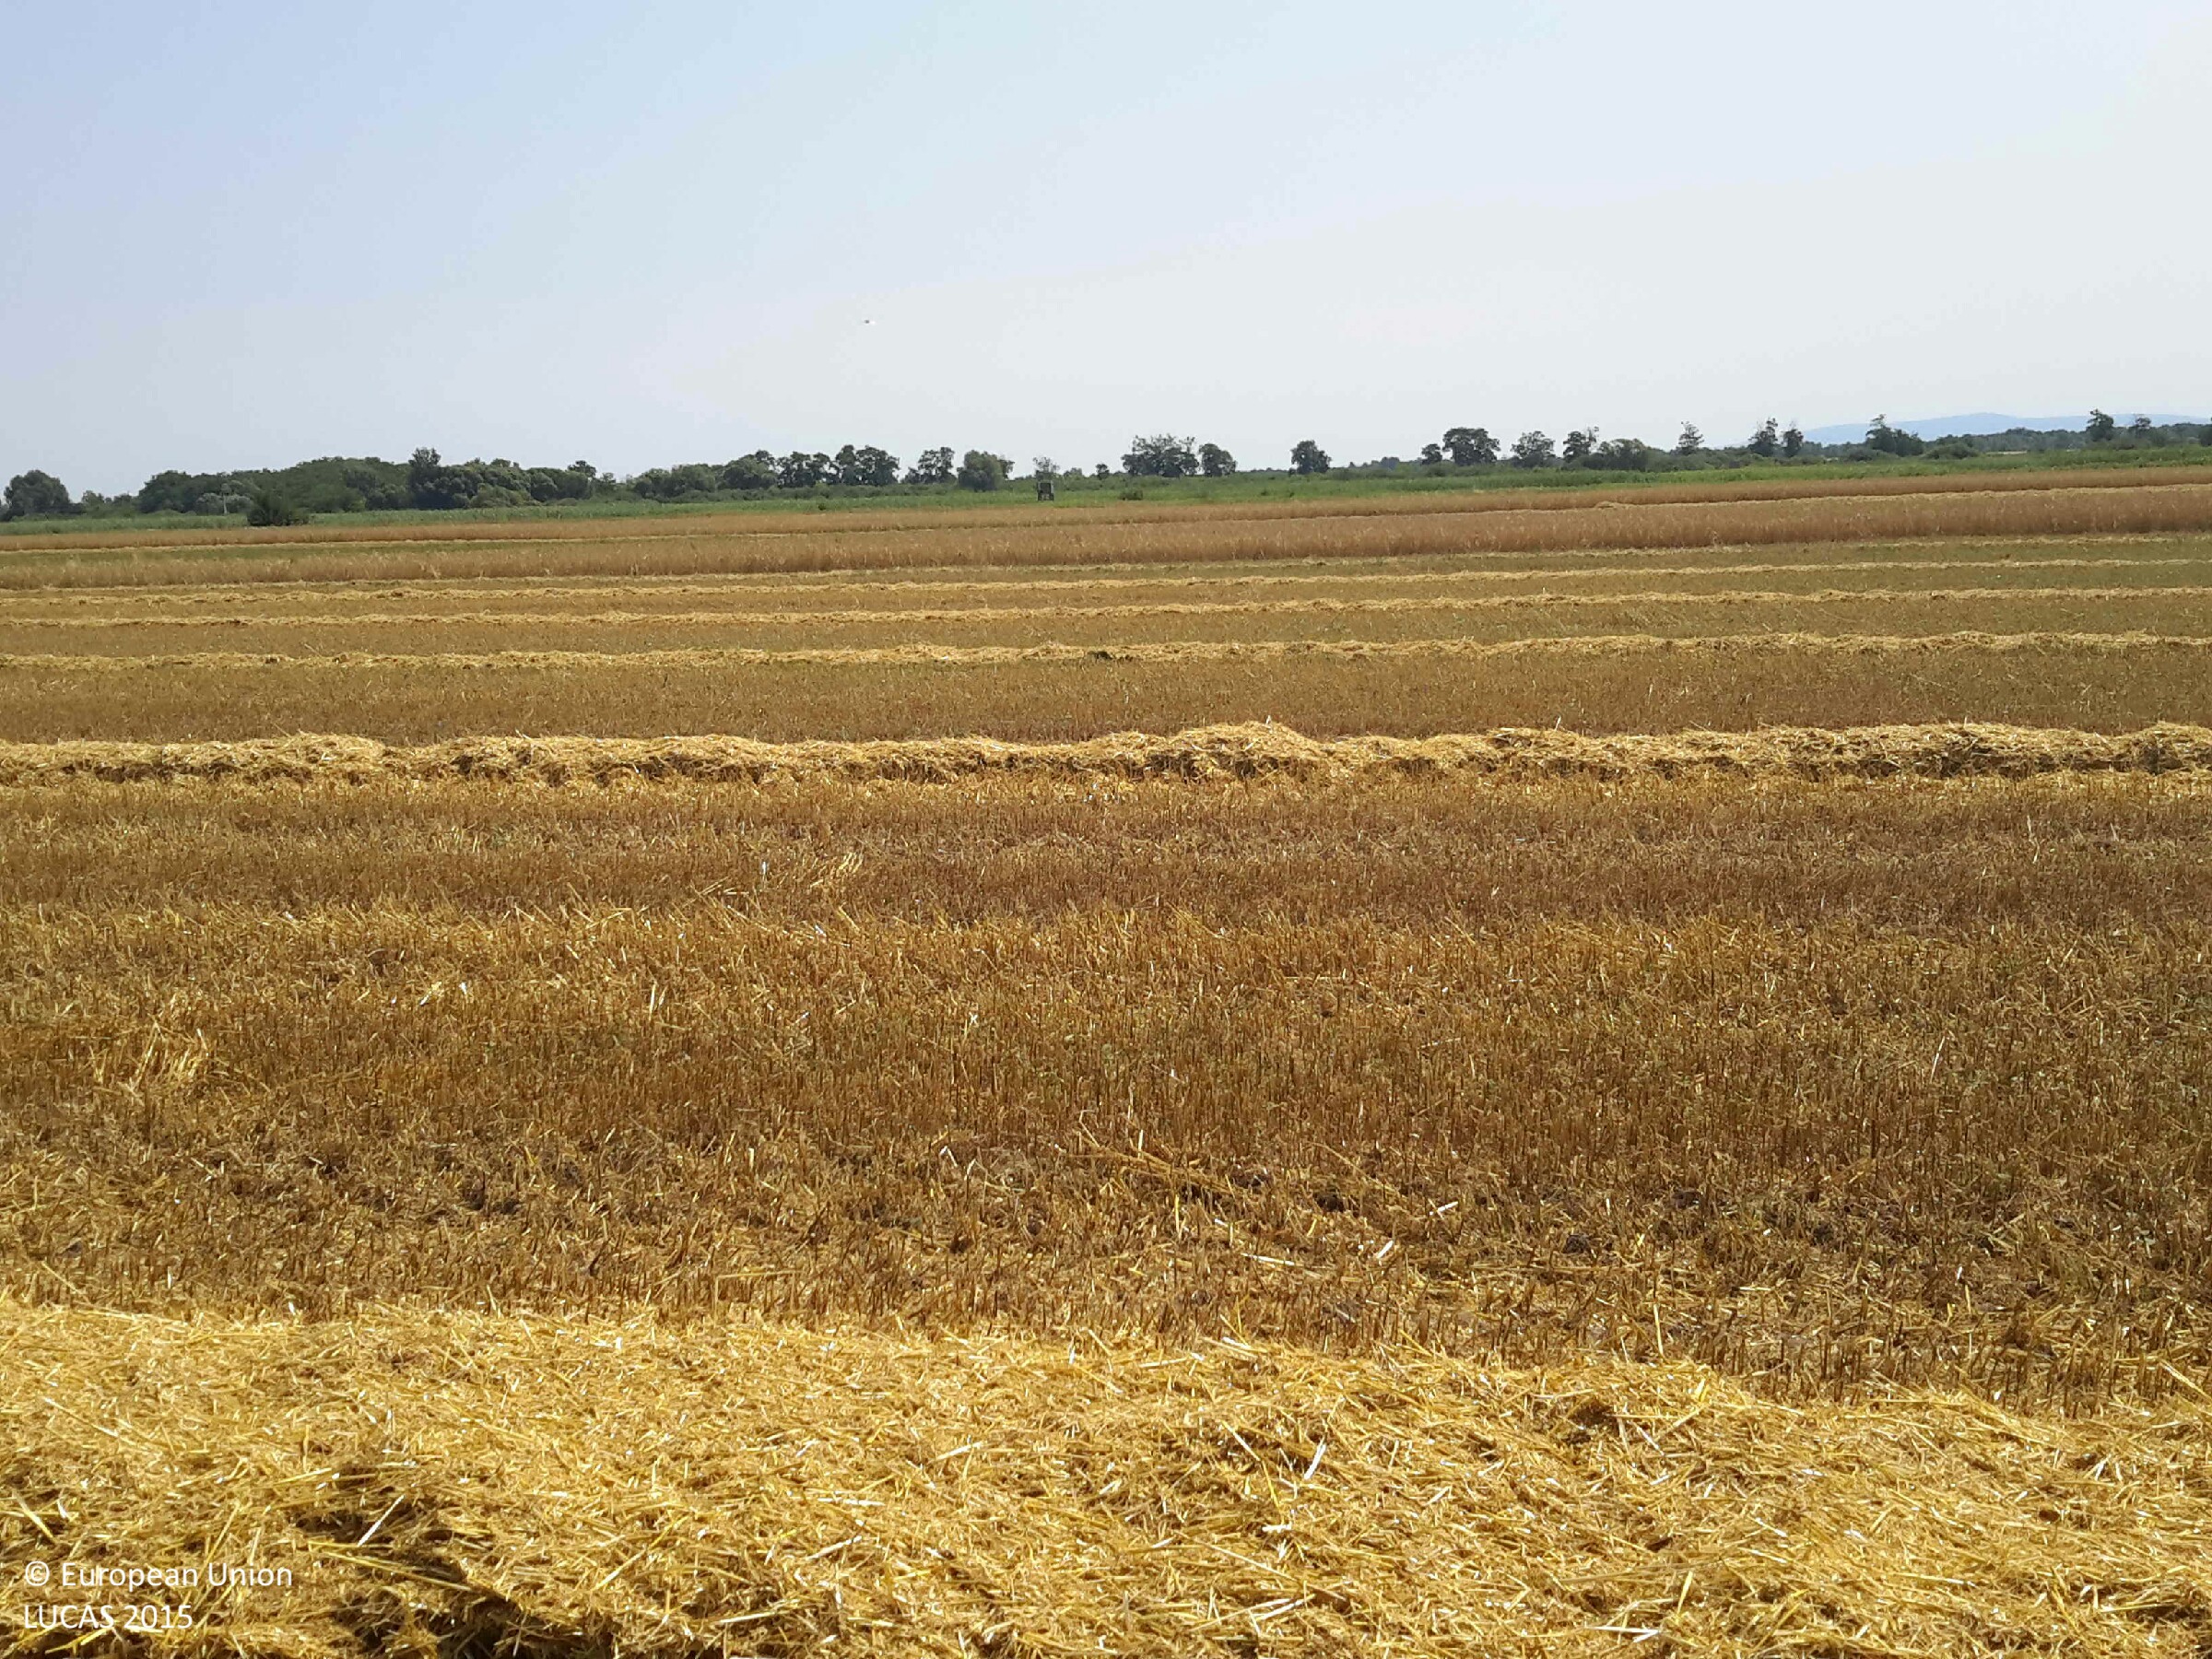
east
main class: Cropland
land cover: Barley
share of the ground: 25 - 50 %
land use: Agriculture (excluding fallow land and kitchen gardens)
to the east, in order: Barley; Grass margins; Tracks; Spontaneously vegetated surfaces
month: July
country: HU
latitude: 47.3471
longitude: 17.3268
